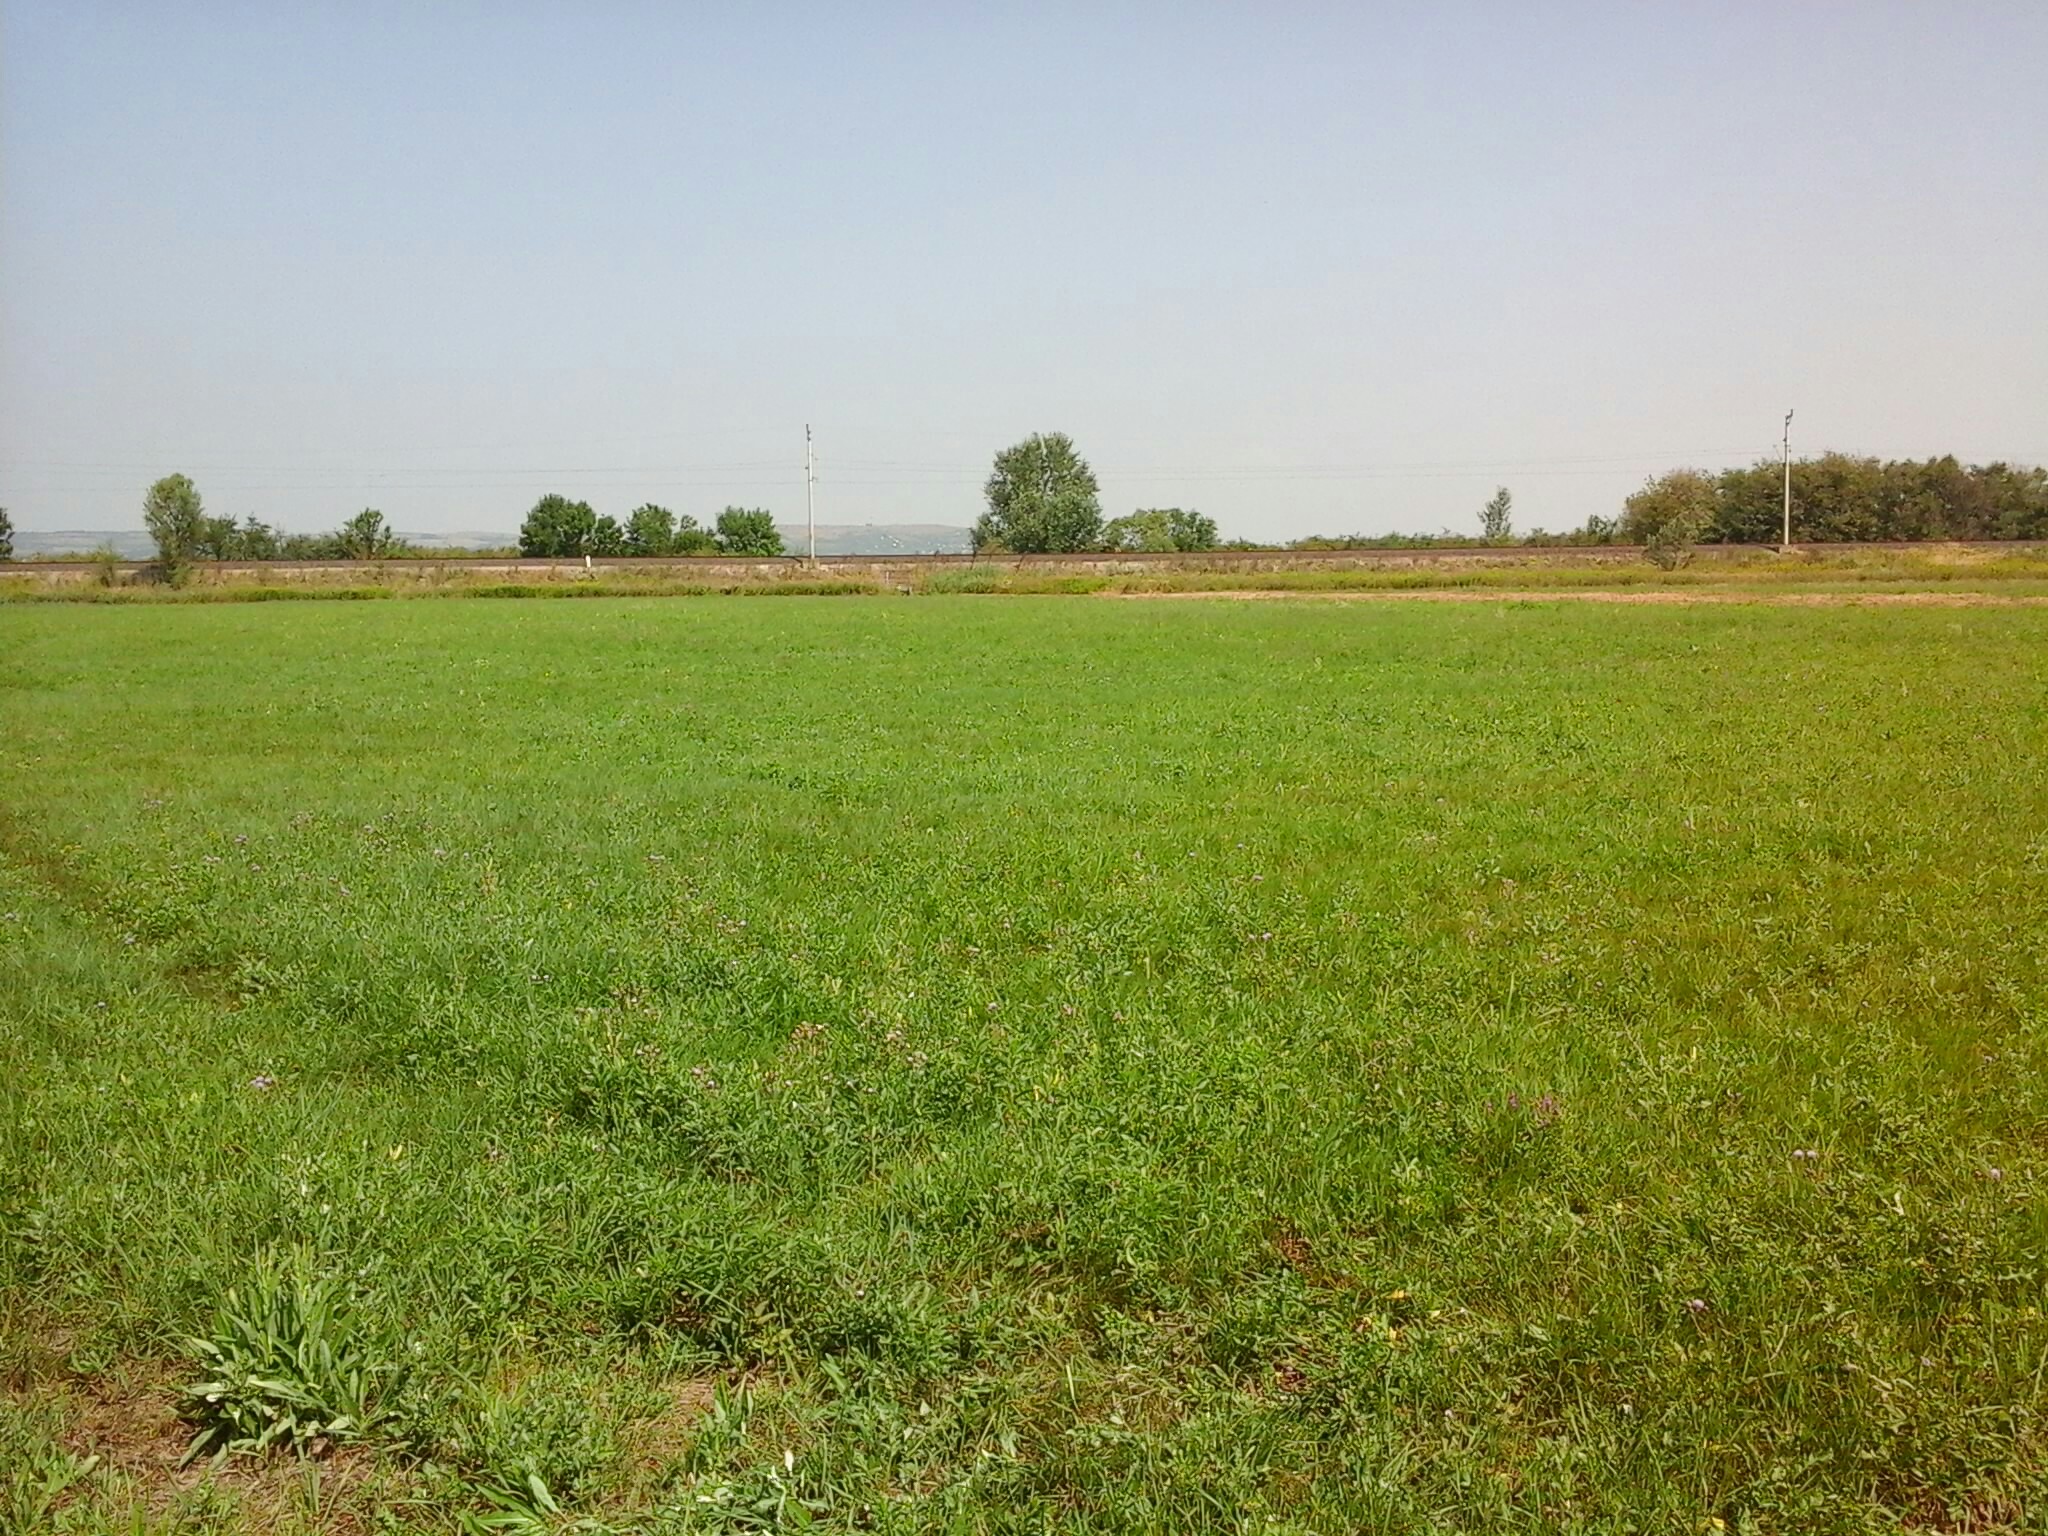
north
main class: Grassland
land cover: Grassland without tree/shrub cover
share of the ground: > 75 %
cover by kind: herbaceous plants 100 %
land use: Agriculture (excluding fallow land and kitchen gardens)
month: August
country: HU
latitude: 47.1697
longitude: 18.2833
